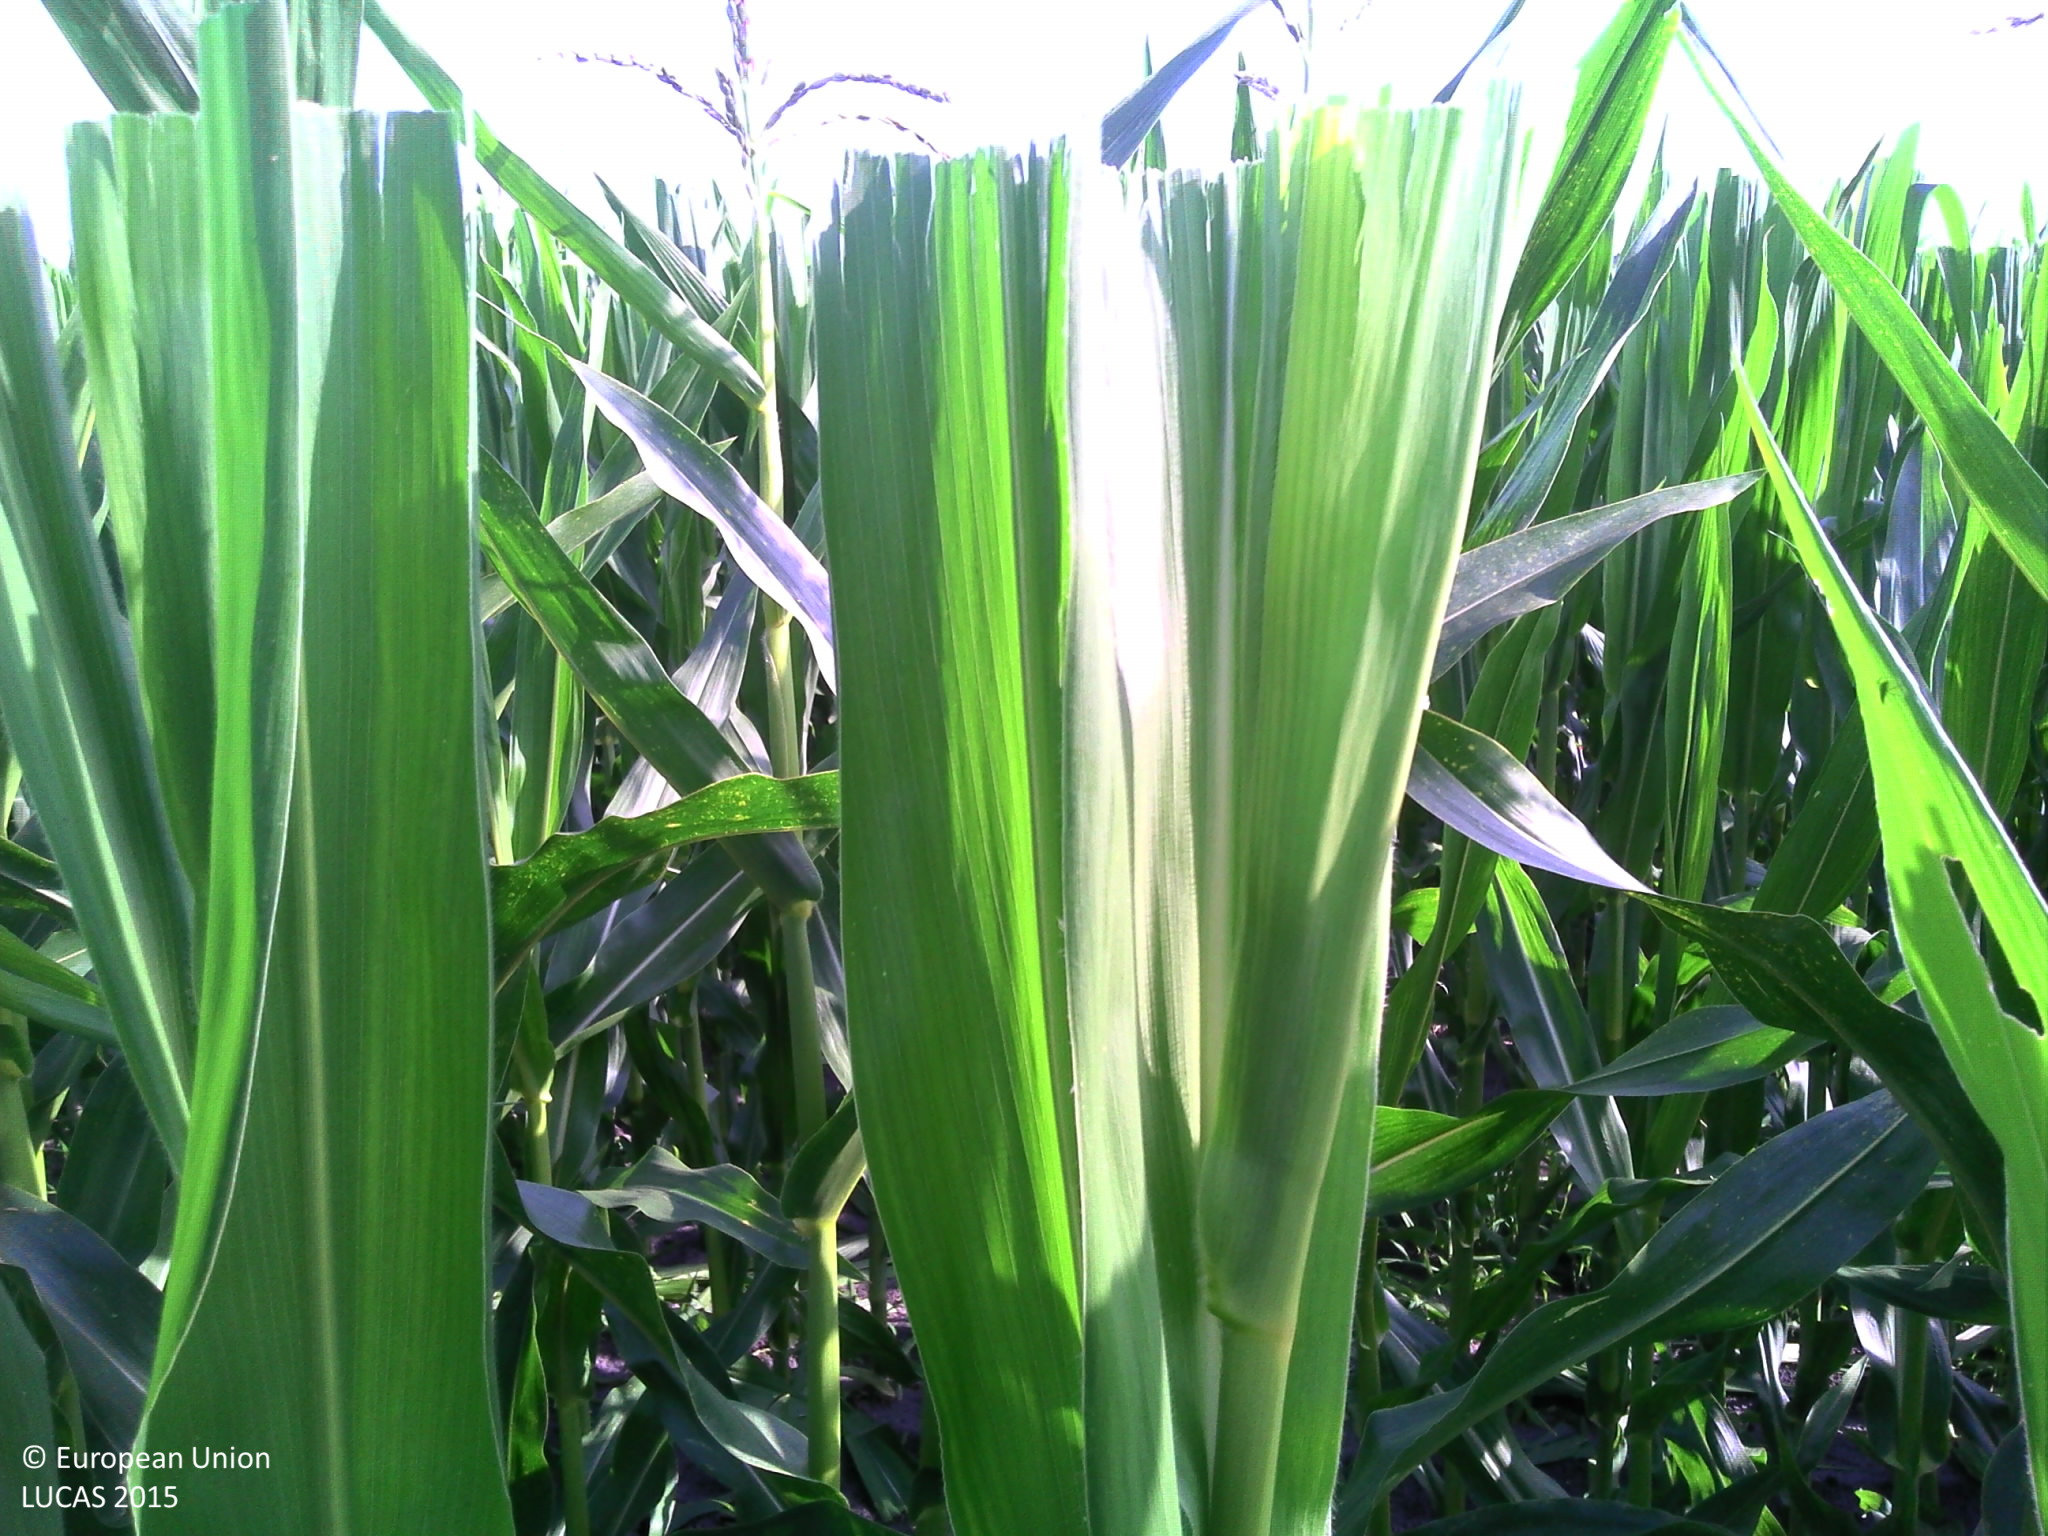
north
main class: Cropland
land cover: Maize
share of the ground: > 75 %
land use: Agriculture (excluding fallow land and kitchen gardens)
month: July
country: FR
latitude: 44.0925
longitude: -0.6437
